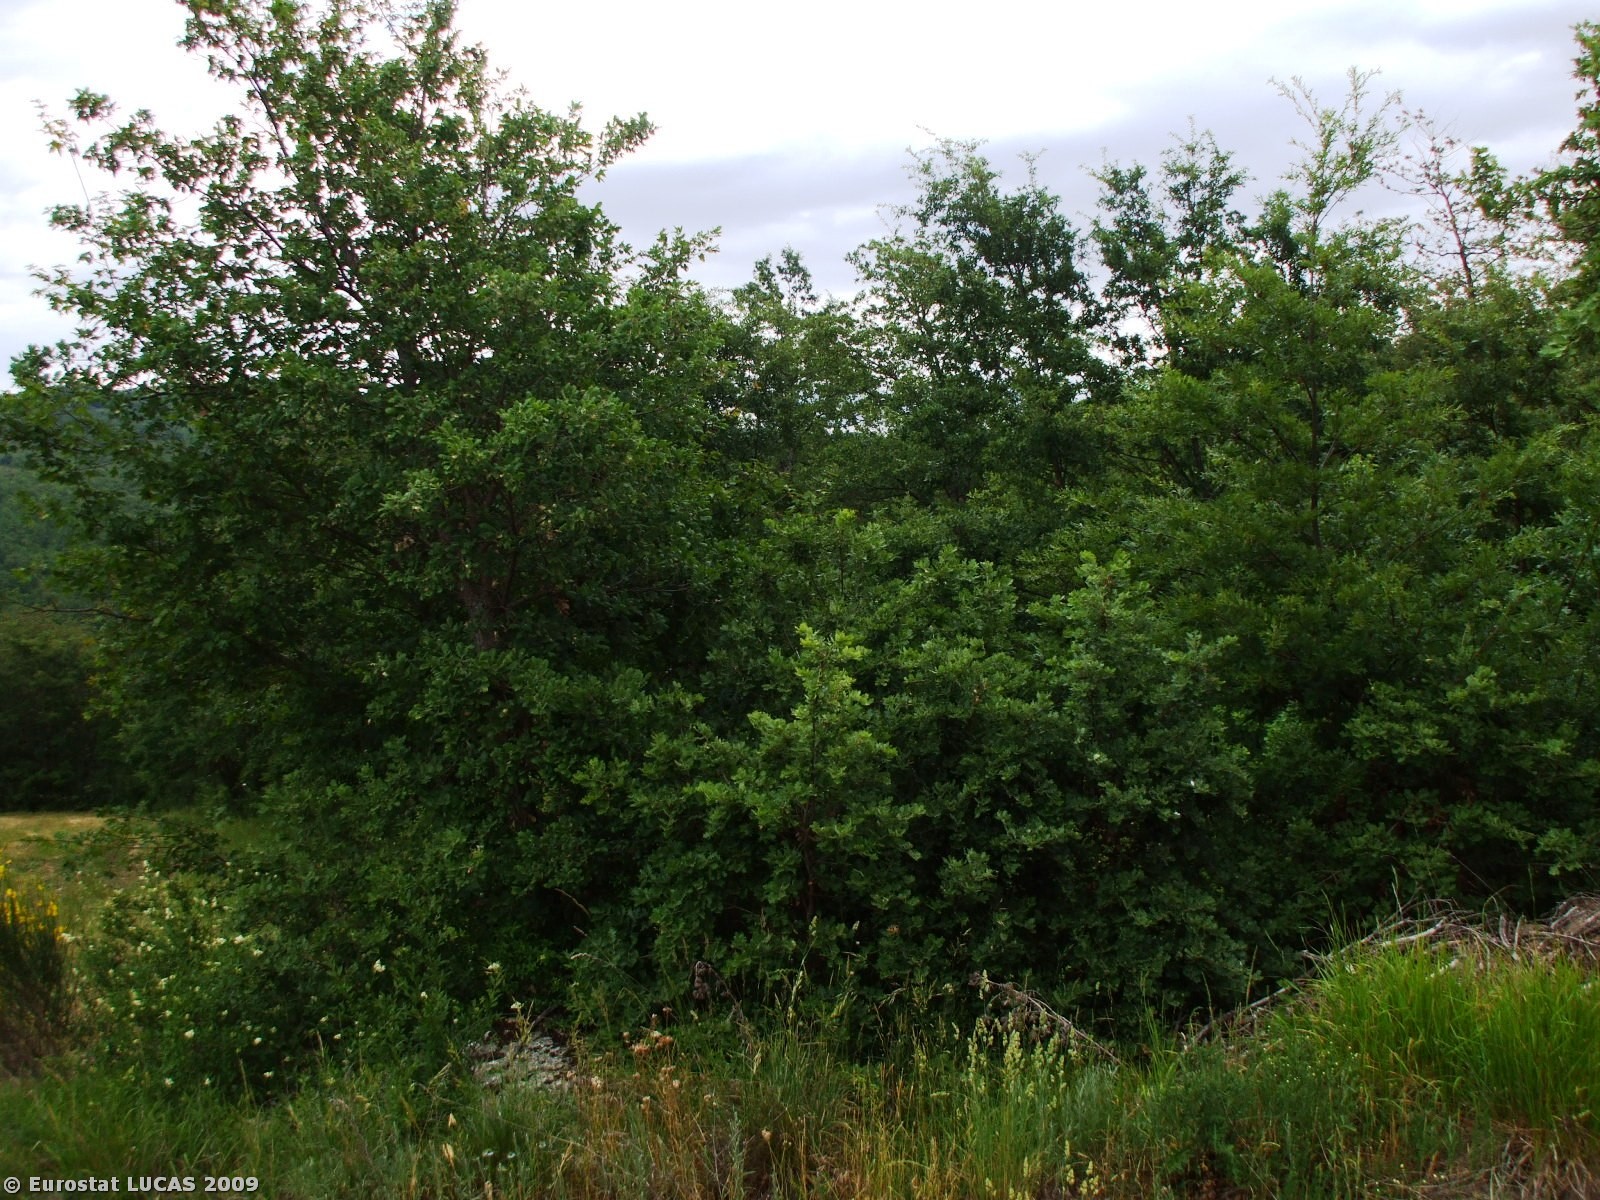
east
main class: Woodland
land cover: Broadleaved woodland
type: thermophilous deciduous forest
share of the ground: > 75 %
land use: Forestry
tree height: > 5 m
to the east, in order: Broadleaved woodland
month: May
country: IT
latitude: 43.6092
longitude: 12.0142
